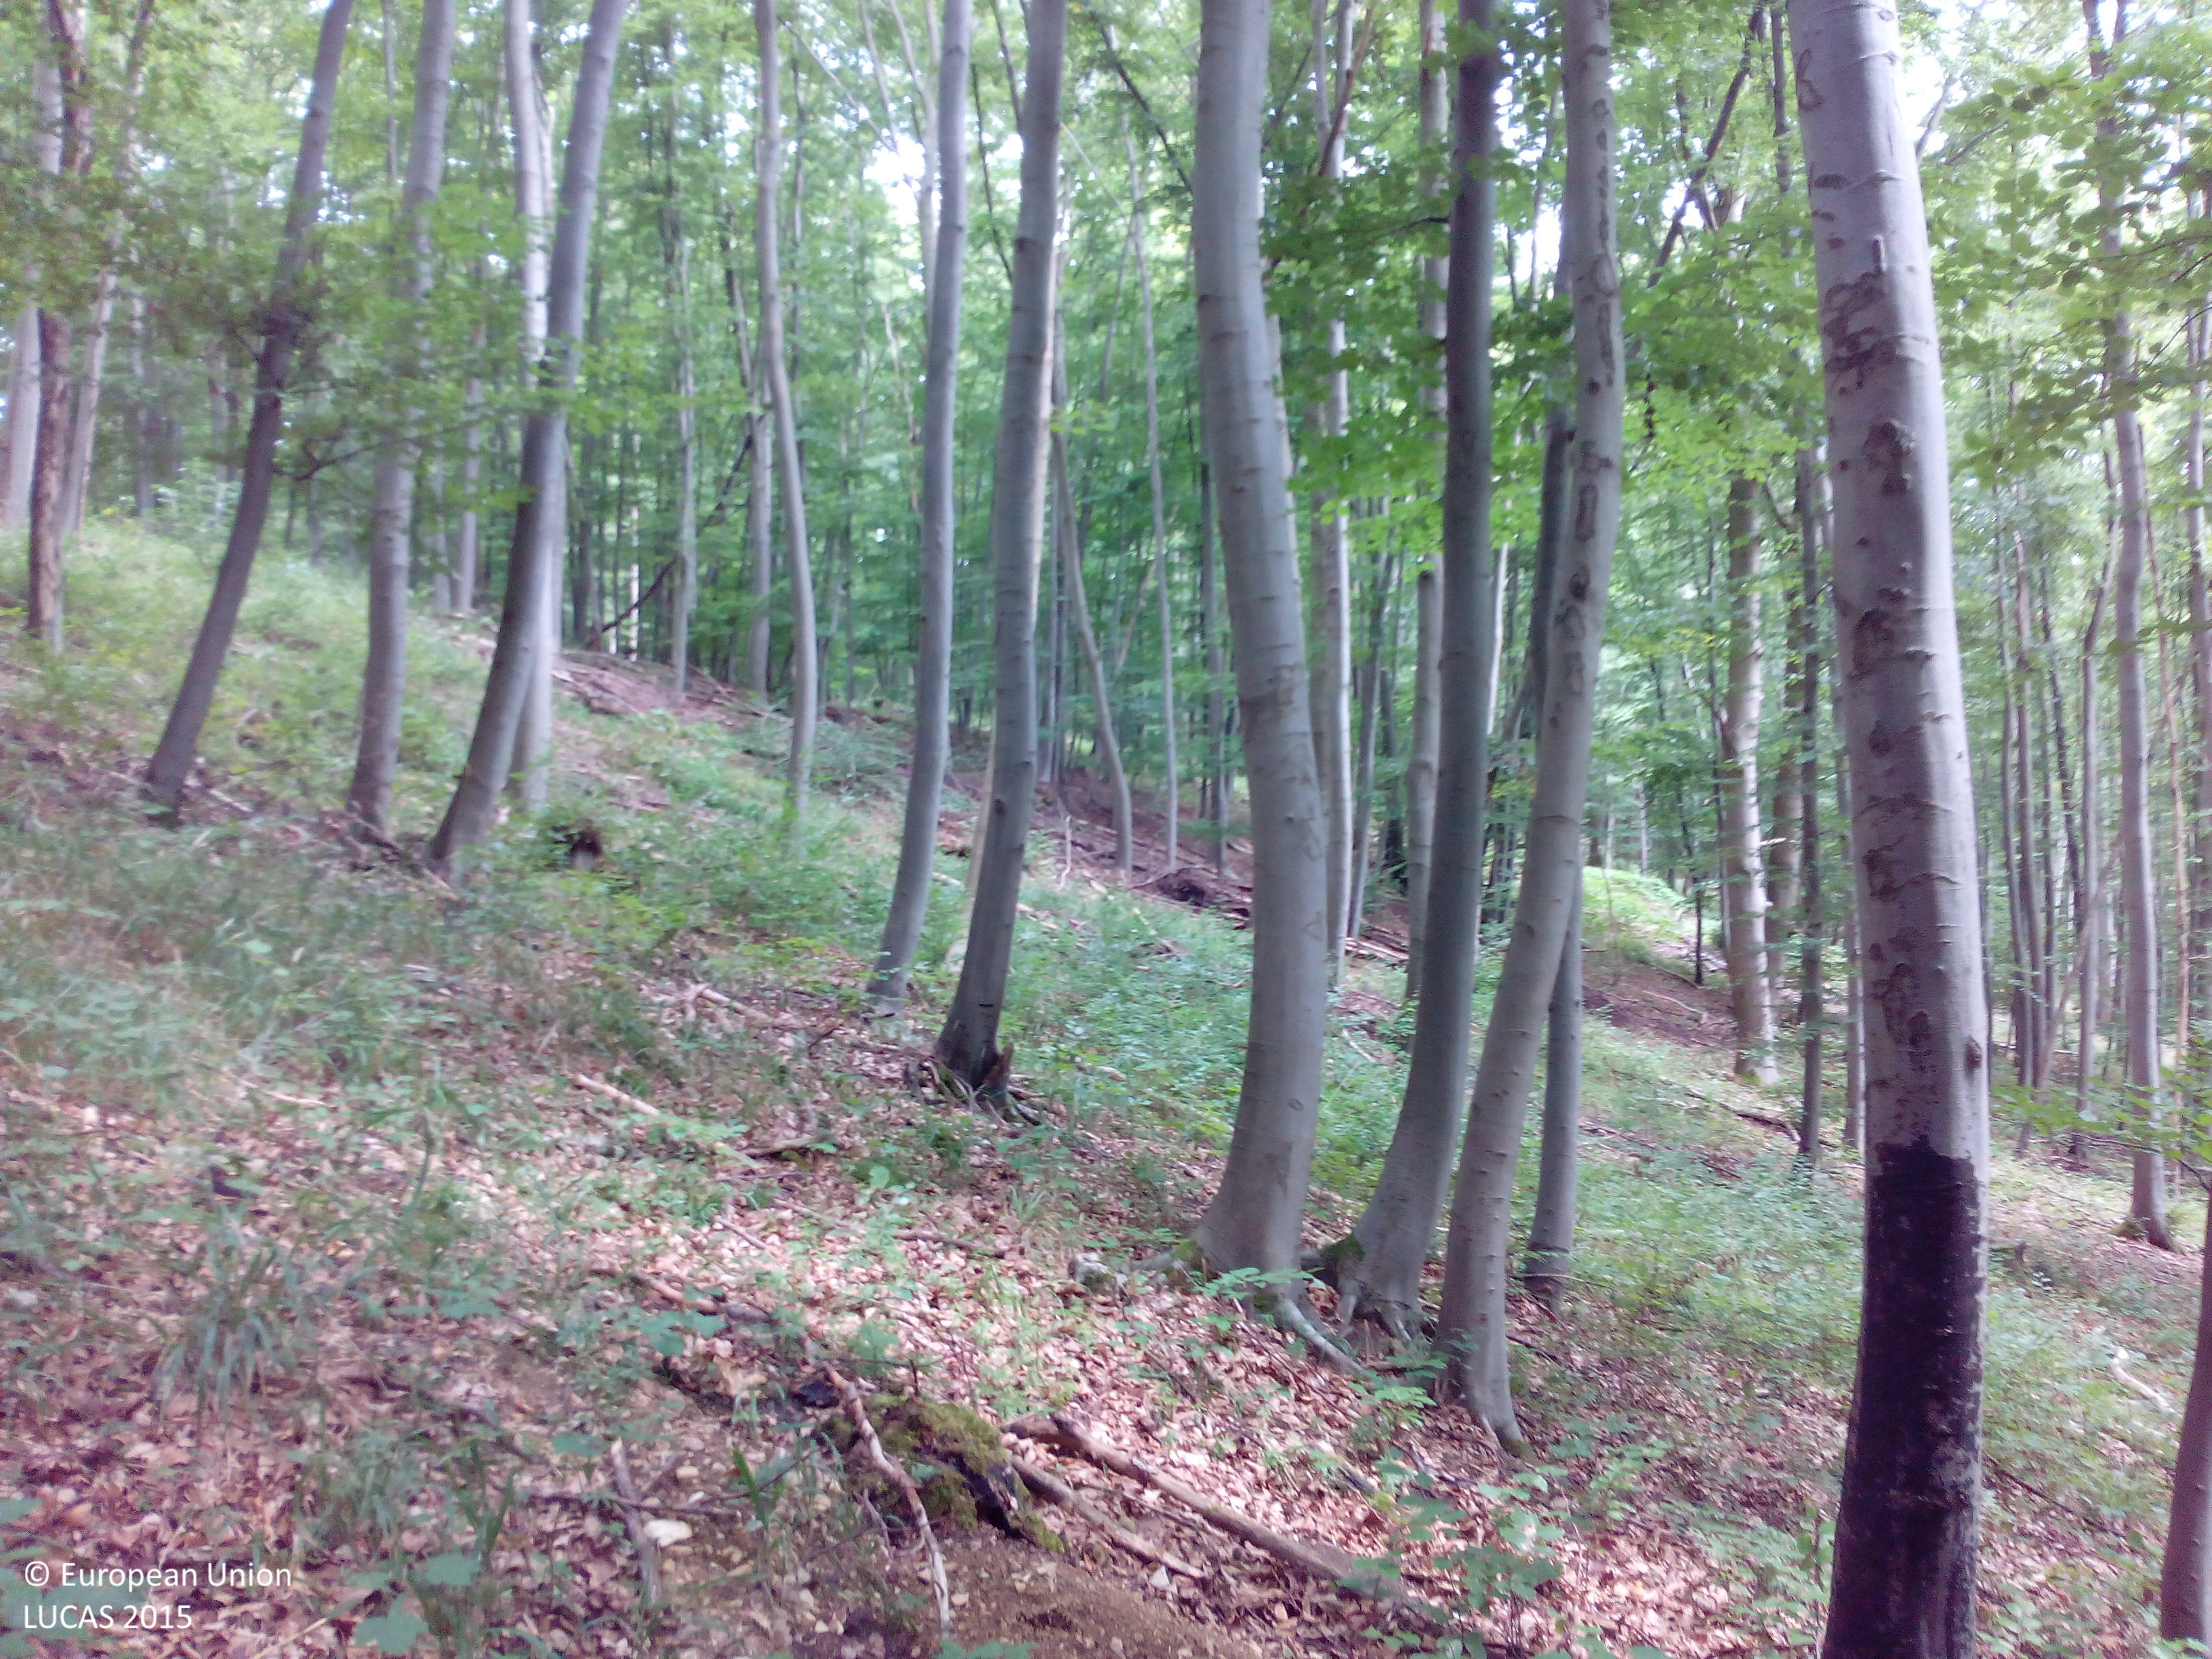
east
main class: Woodland
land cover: Broadleaved woodland
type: beech forest
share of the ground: > 75 %
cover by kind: broadleaved forest trees 100 %
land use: Forestry
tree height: > 5 m
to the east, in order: Broadleaved woodland; Tracks; Broadleaved woodland; Tracks; Broadleaved woodland; Tracks; Broadleaved woodland; Tracks; Broadleaved woodland
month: August
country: DE
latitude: 51.0829
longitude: 10.2711
